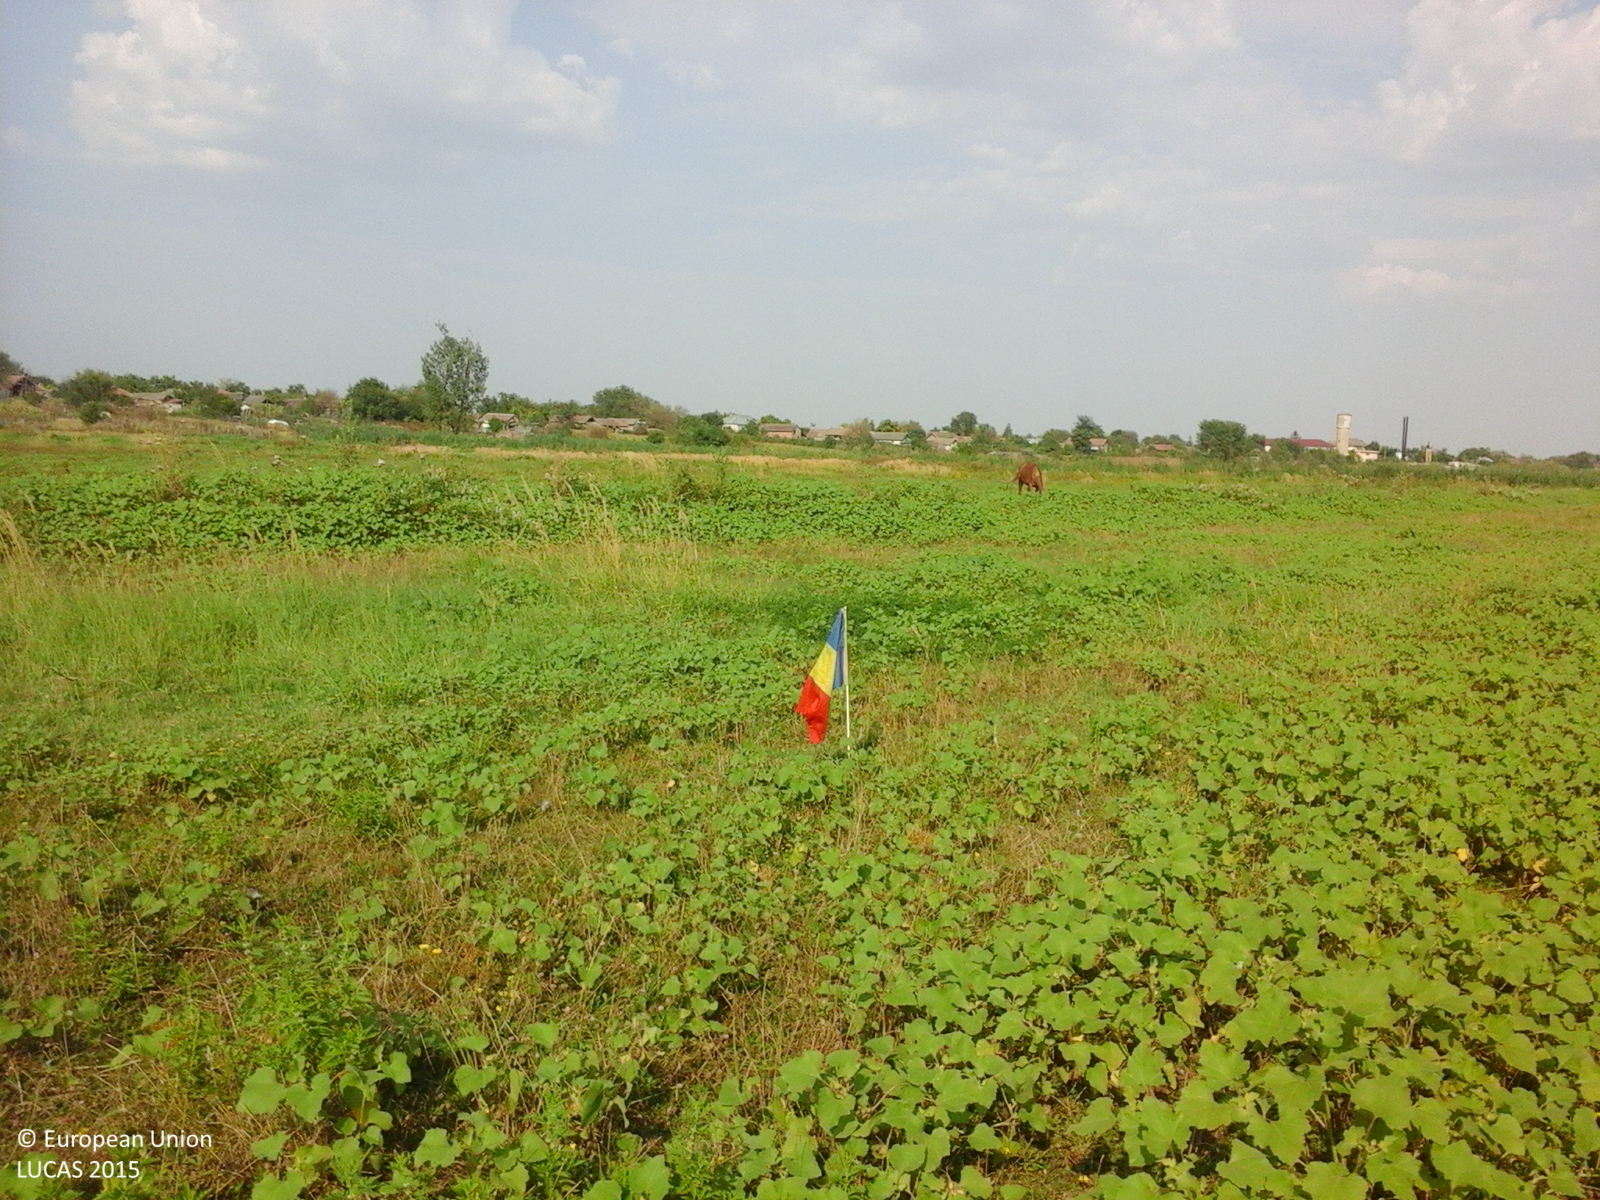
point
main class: Grassland
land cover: Spontaneously vegetated surfaces
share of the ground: > 75 %
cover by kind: herbaceous plants 100 %
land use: Agriculture (excluding fallow land and kitchen gardens)
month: August
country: RO
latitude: 43.8751
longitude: 23.7032
